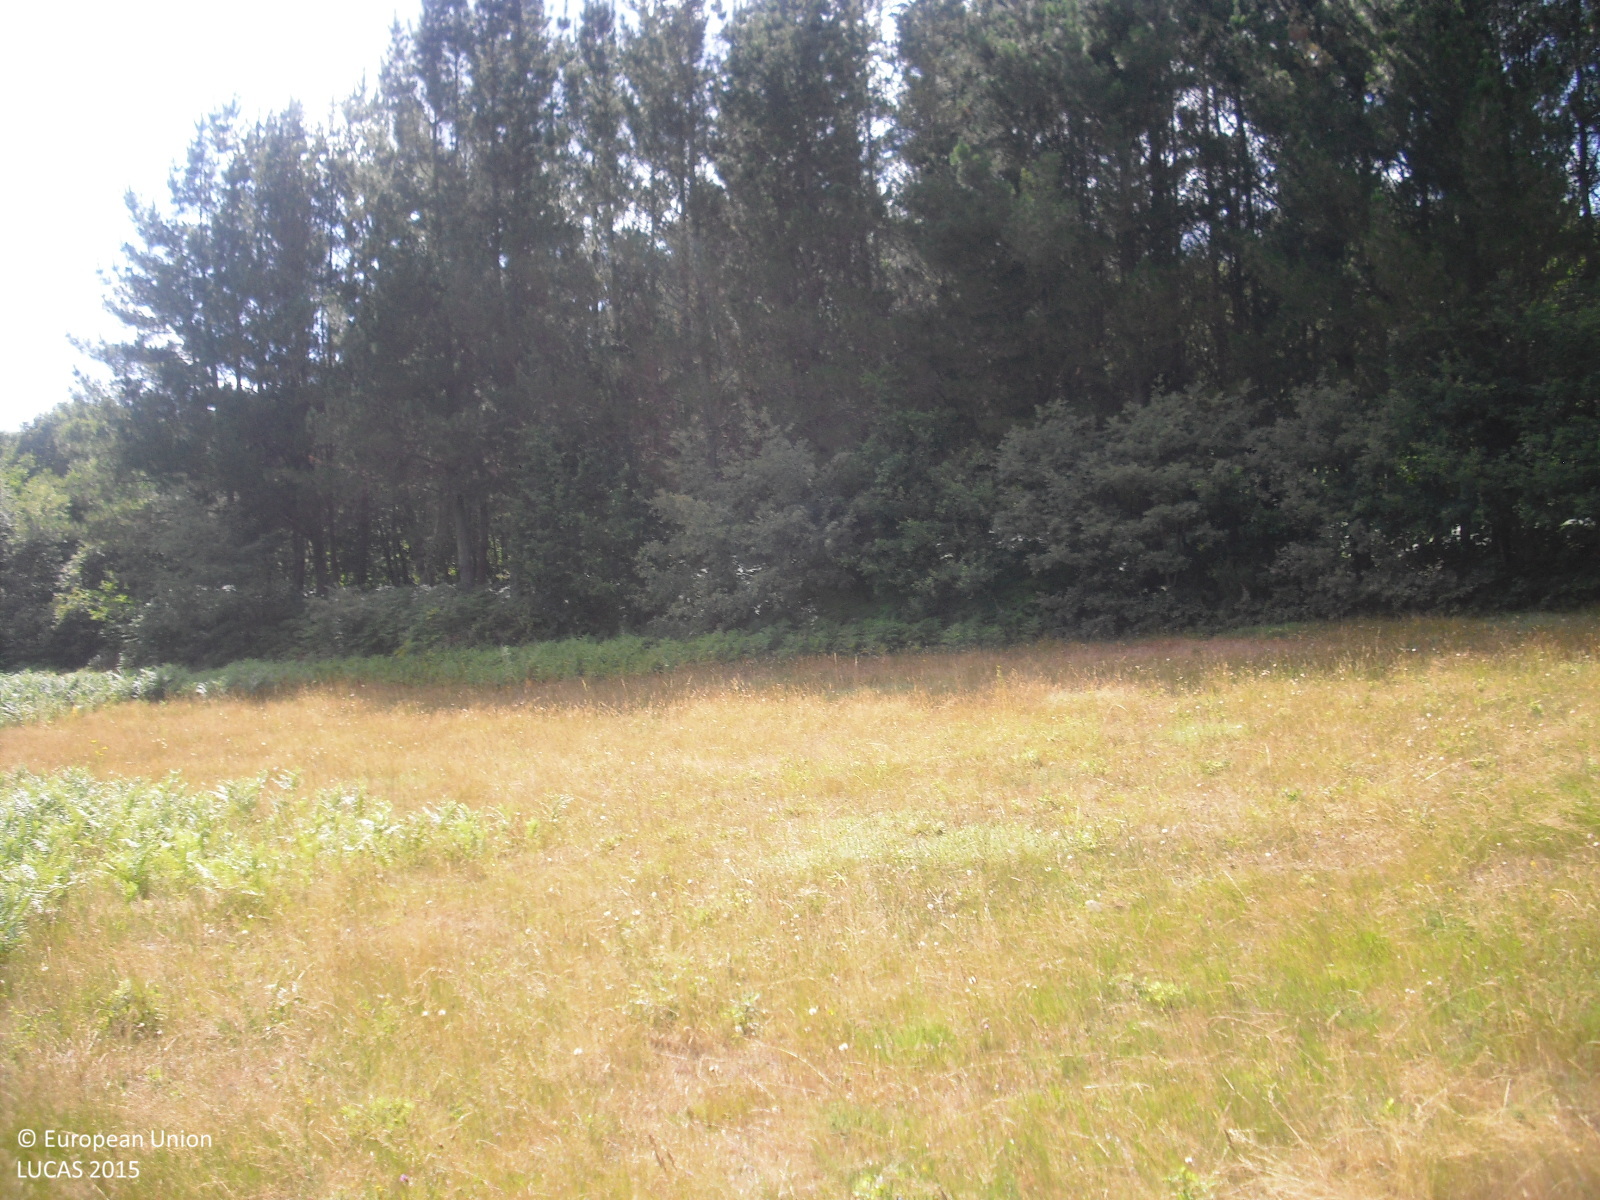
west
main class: Woodland
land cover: Broadleaved woodland
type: thermophilous deciduous forest
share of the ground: 50 - 75 %
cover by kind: broadleaved forest trees 60 %, shrubs 30 %, herbaceous plants 10 %
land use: Forestry
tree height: > 5 m
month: July
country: ES
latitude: 42.3376
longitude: -7.6830
